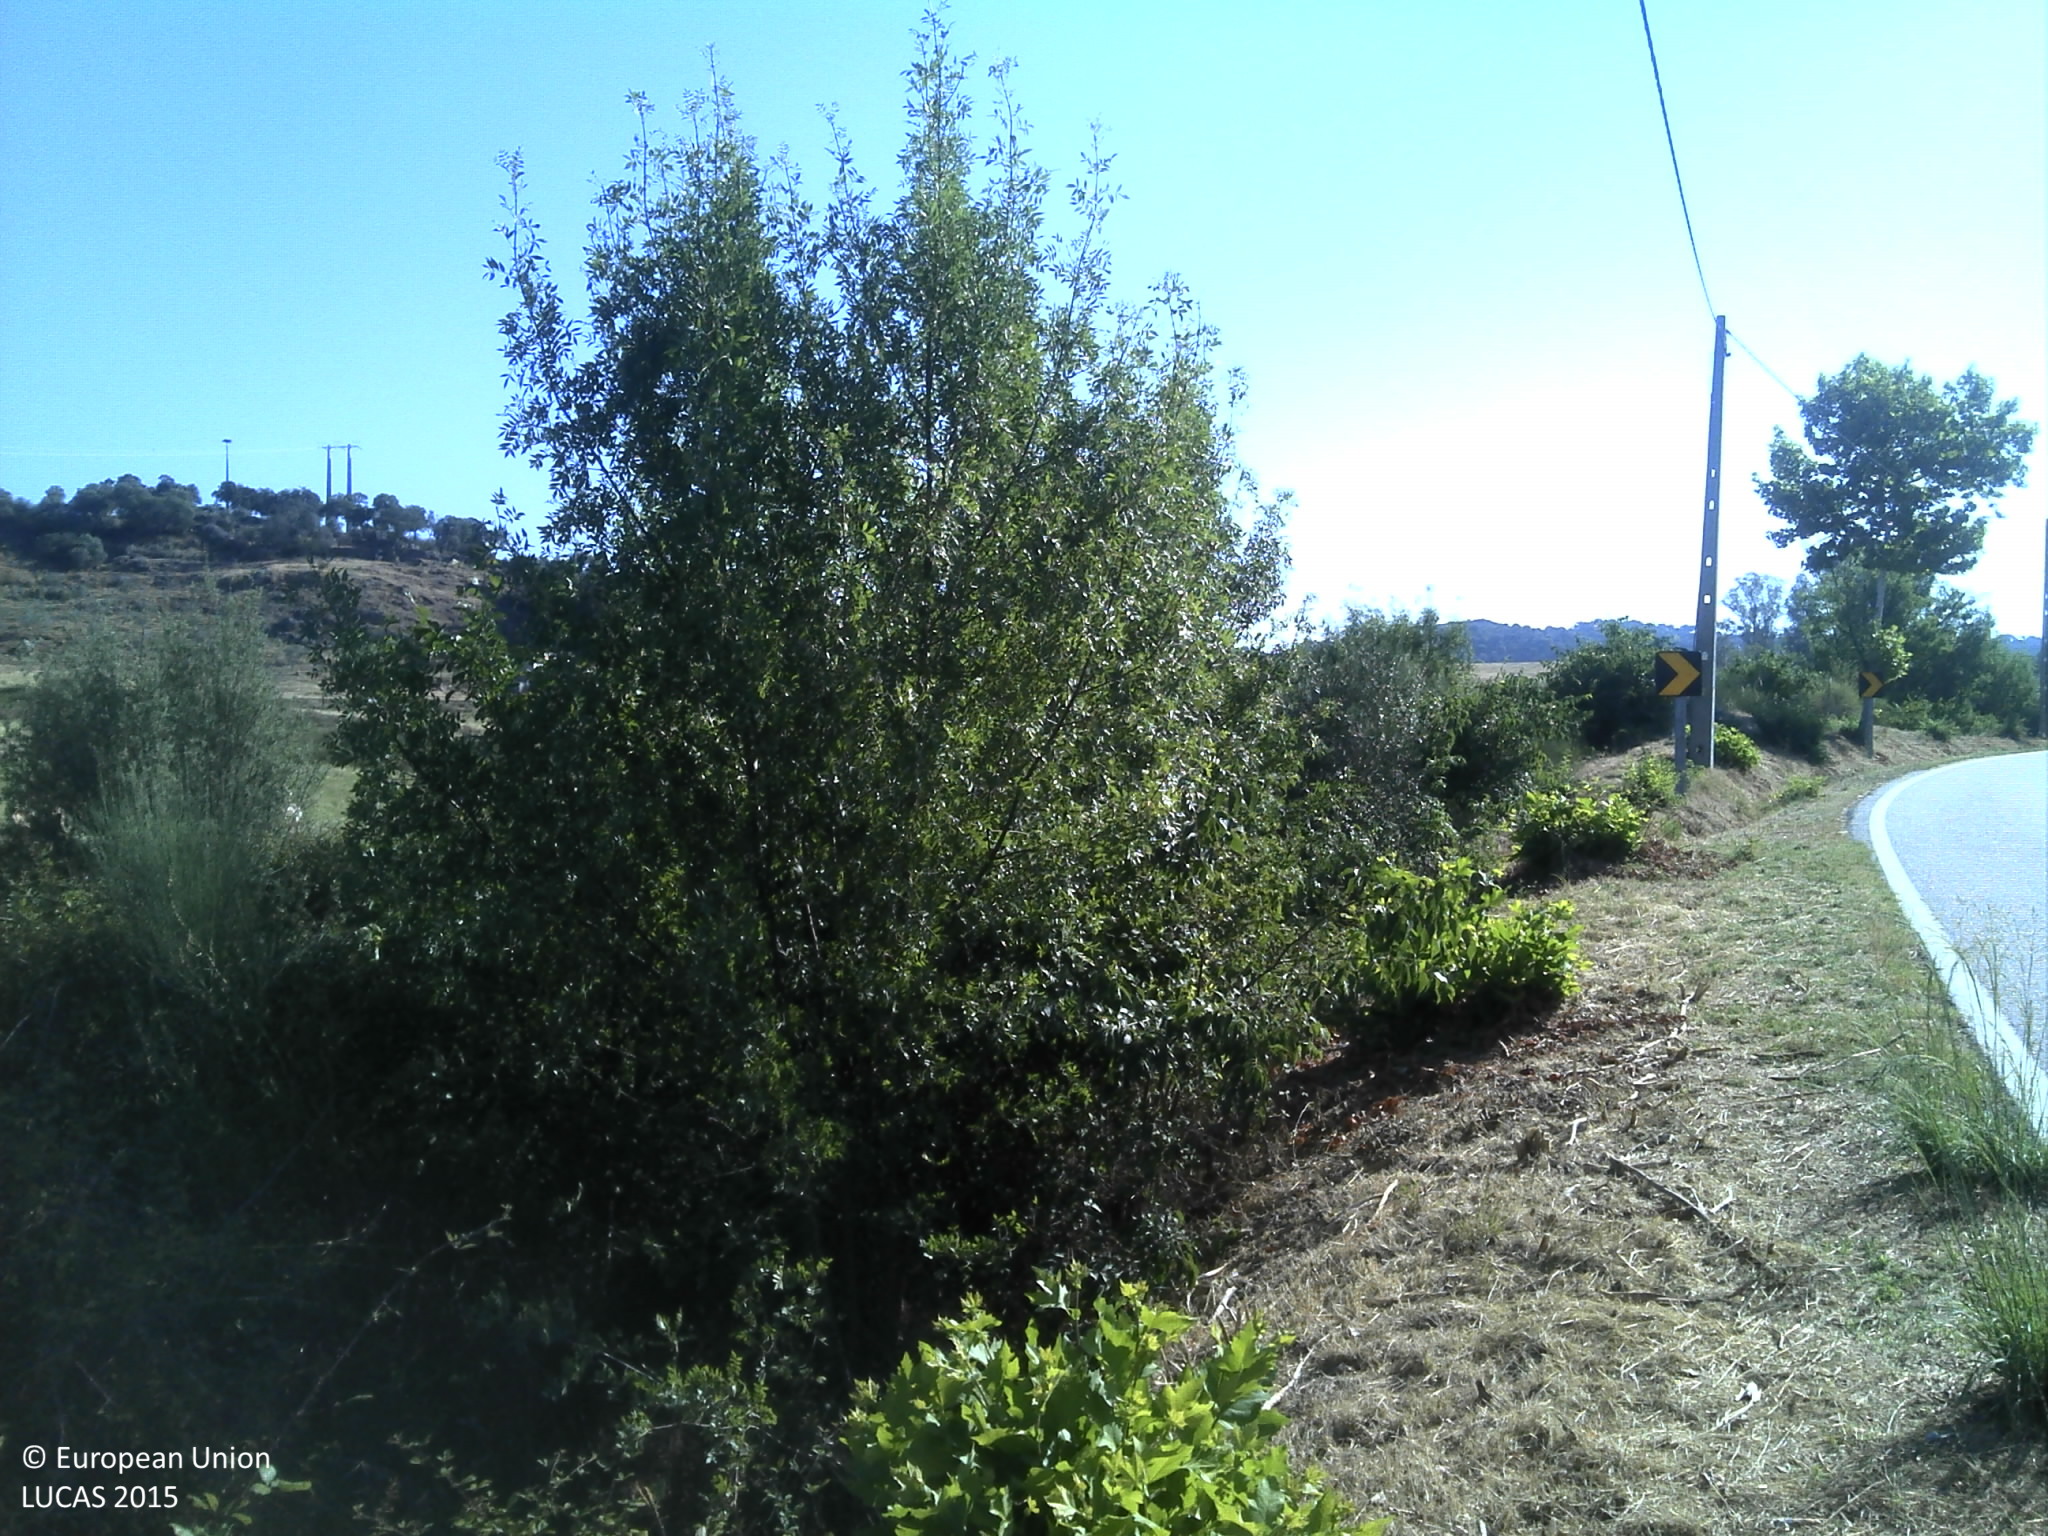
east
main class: Grassland
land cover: Grassland with sparse tree/shrub cover
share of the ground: 50 - 75 %
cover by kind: herbaceous plants 55 %, unconsolidated bare surface 30 %, broadleaved forest trees 5 %, shrubs 5 %
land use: Agriculture (excluding fallow land and kitchen gardens)
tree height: > 5 m
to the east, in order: Grassland with sparse tree/shrub cover; Shruby margins; Grassland without tree/shrub cover; Grassland with sparse tree/shrub cover; Broadleaved woodland
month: June
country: PT
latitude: 39.9104
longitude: -7.2319
